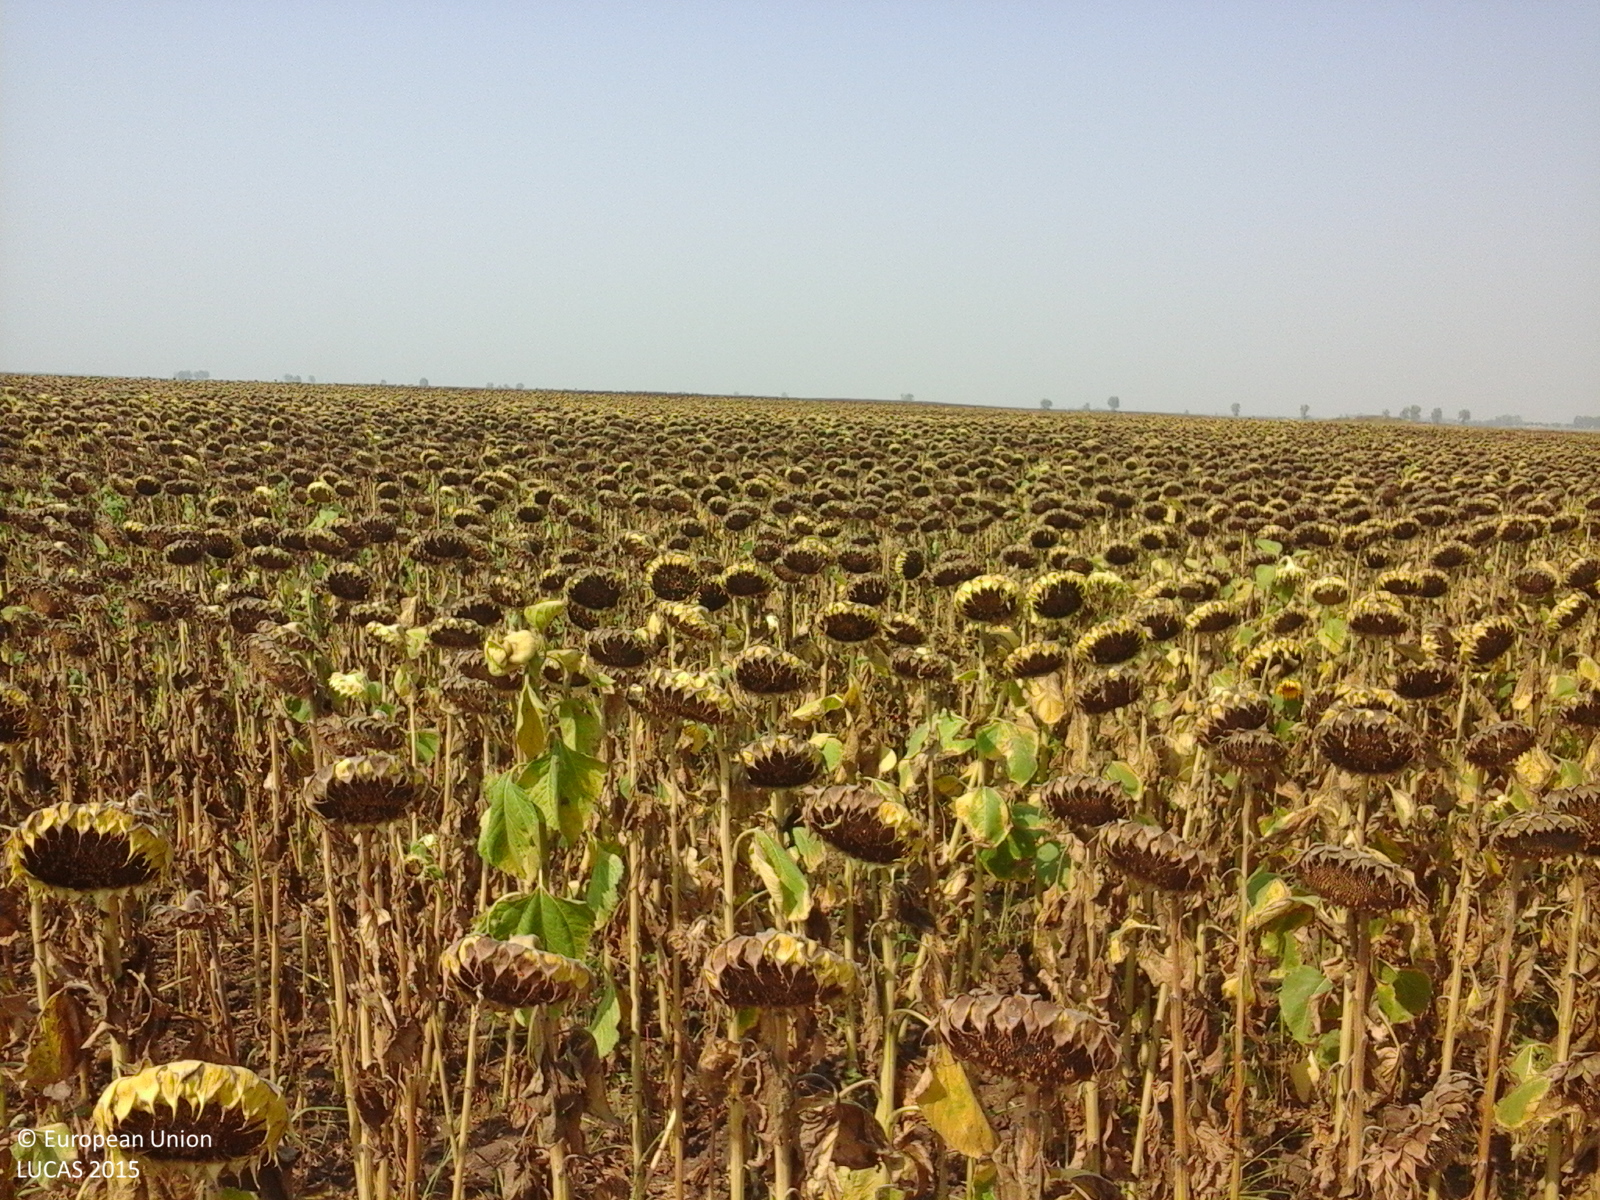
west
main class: Cropland
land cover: Sunflower
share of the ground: > 75 %
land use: Agriculture (excluding fallow land and kitchen gardens)
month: August
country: RO
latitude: 43.9188
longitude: 23.2329
